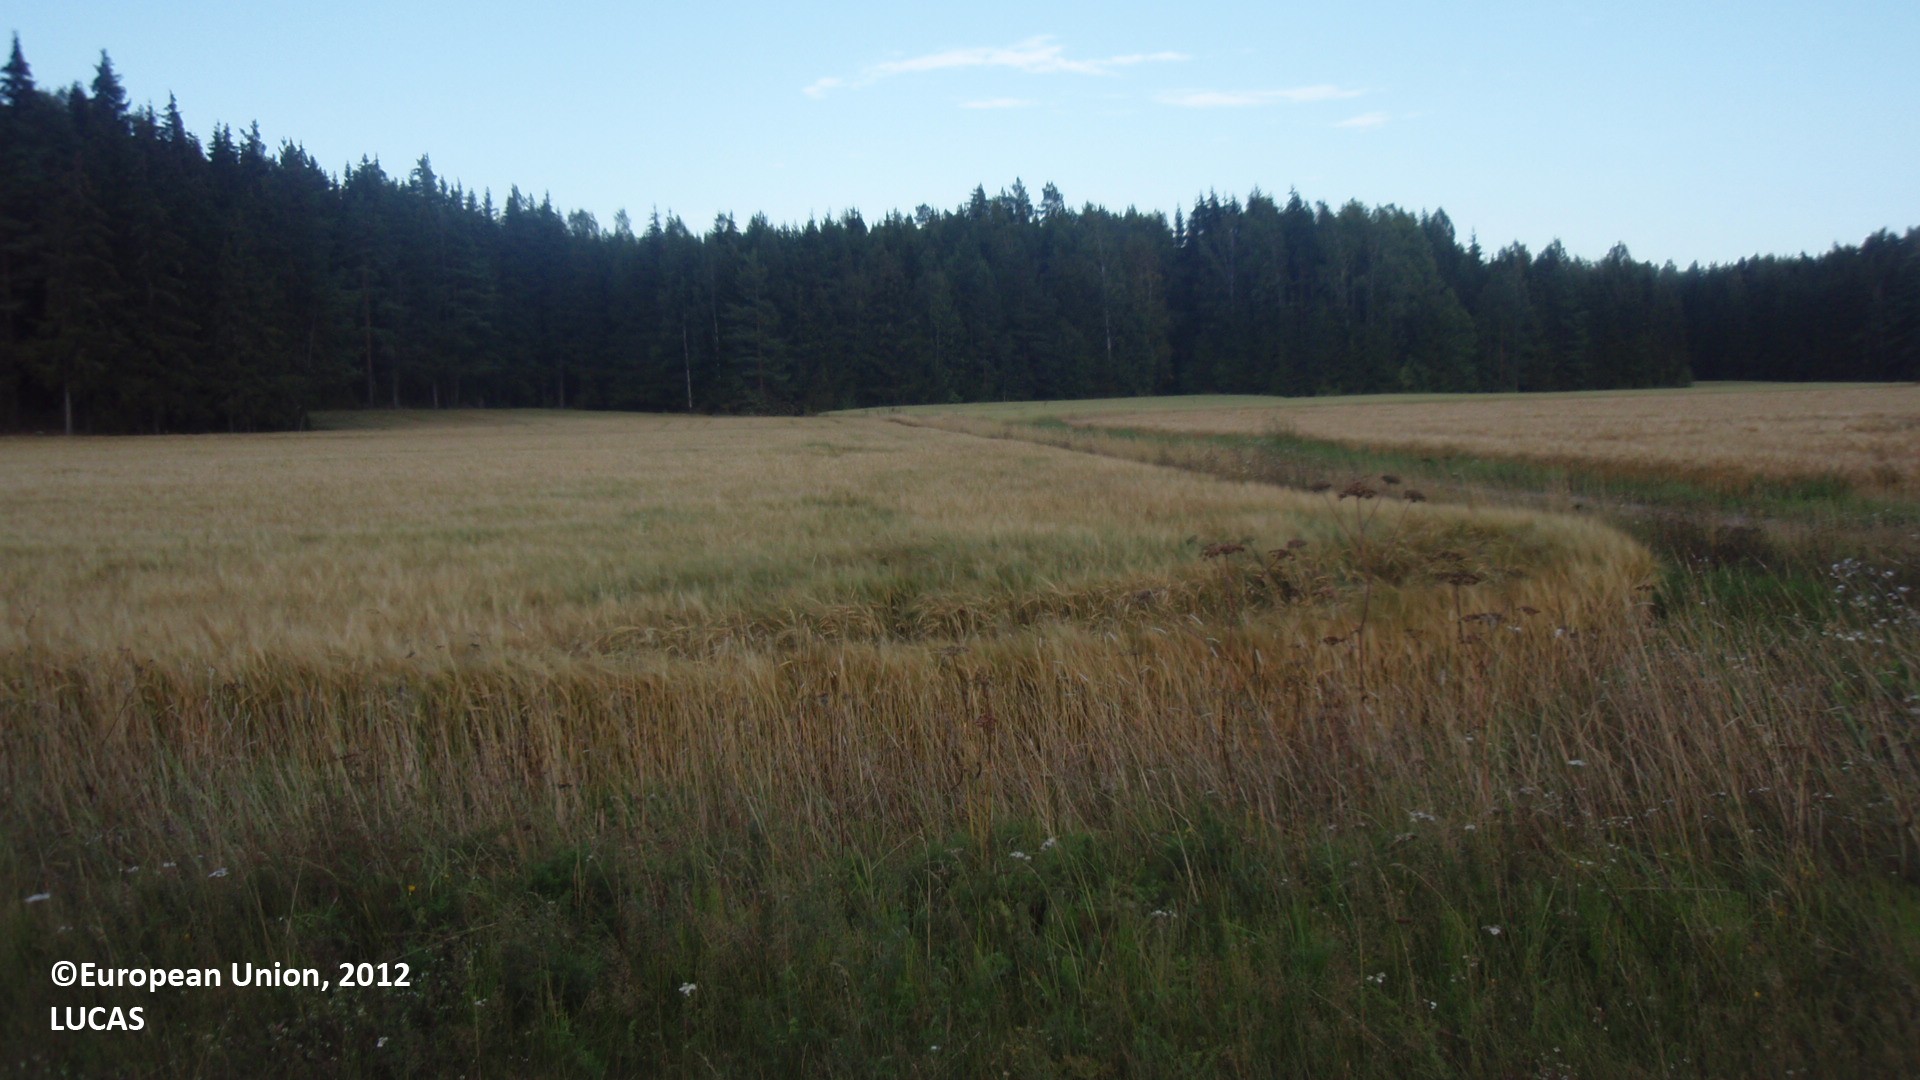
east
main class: Cropland
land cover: Oats
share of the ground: > 75 %
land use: Agriculture (excluding fallow land and kitchen gardens)
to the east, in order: Oats; Single bushes/trees; Ditches and canals; Grass margins; Tracks; Grass margins; Ditches and canals; Grass margins; Barley
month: August
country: FI
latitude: 60.6975
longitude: 26.6250
